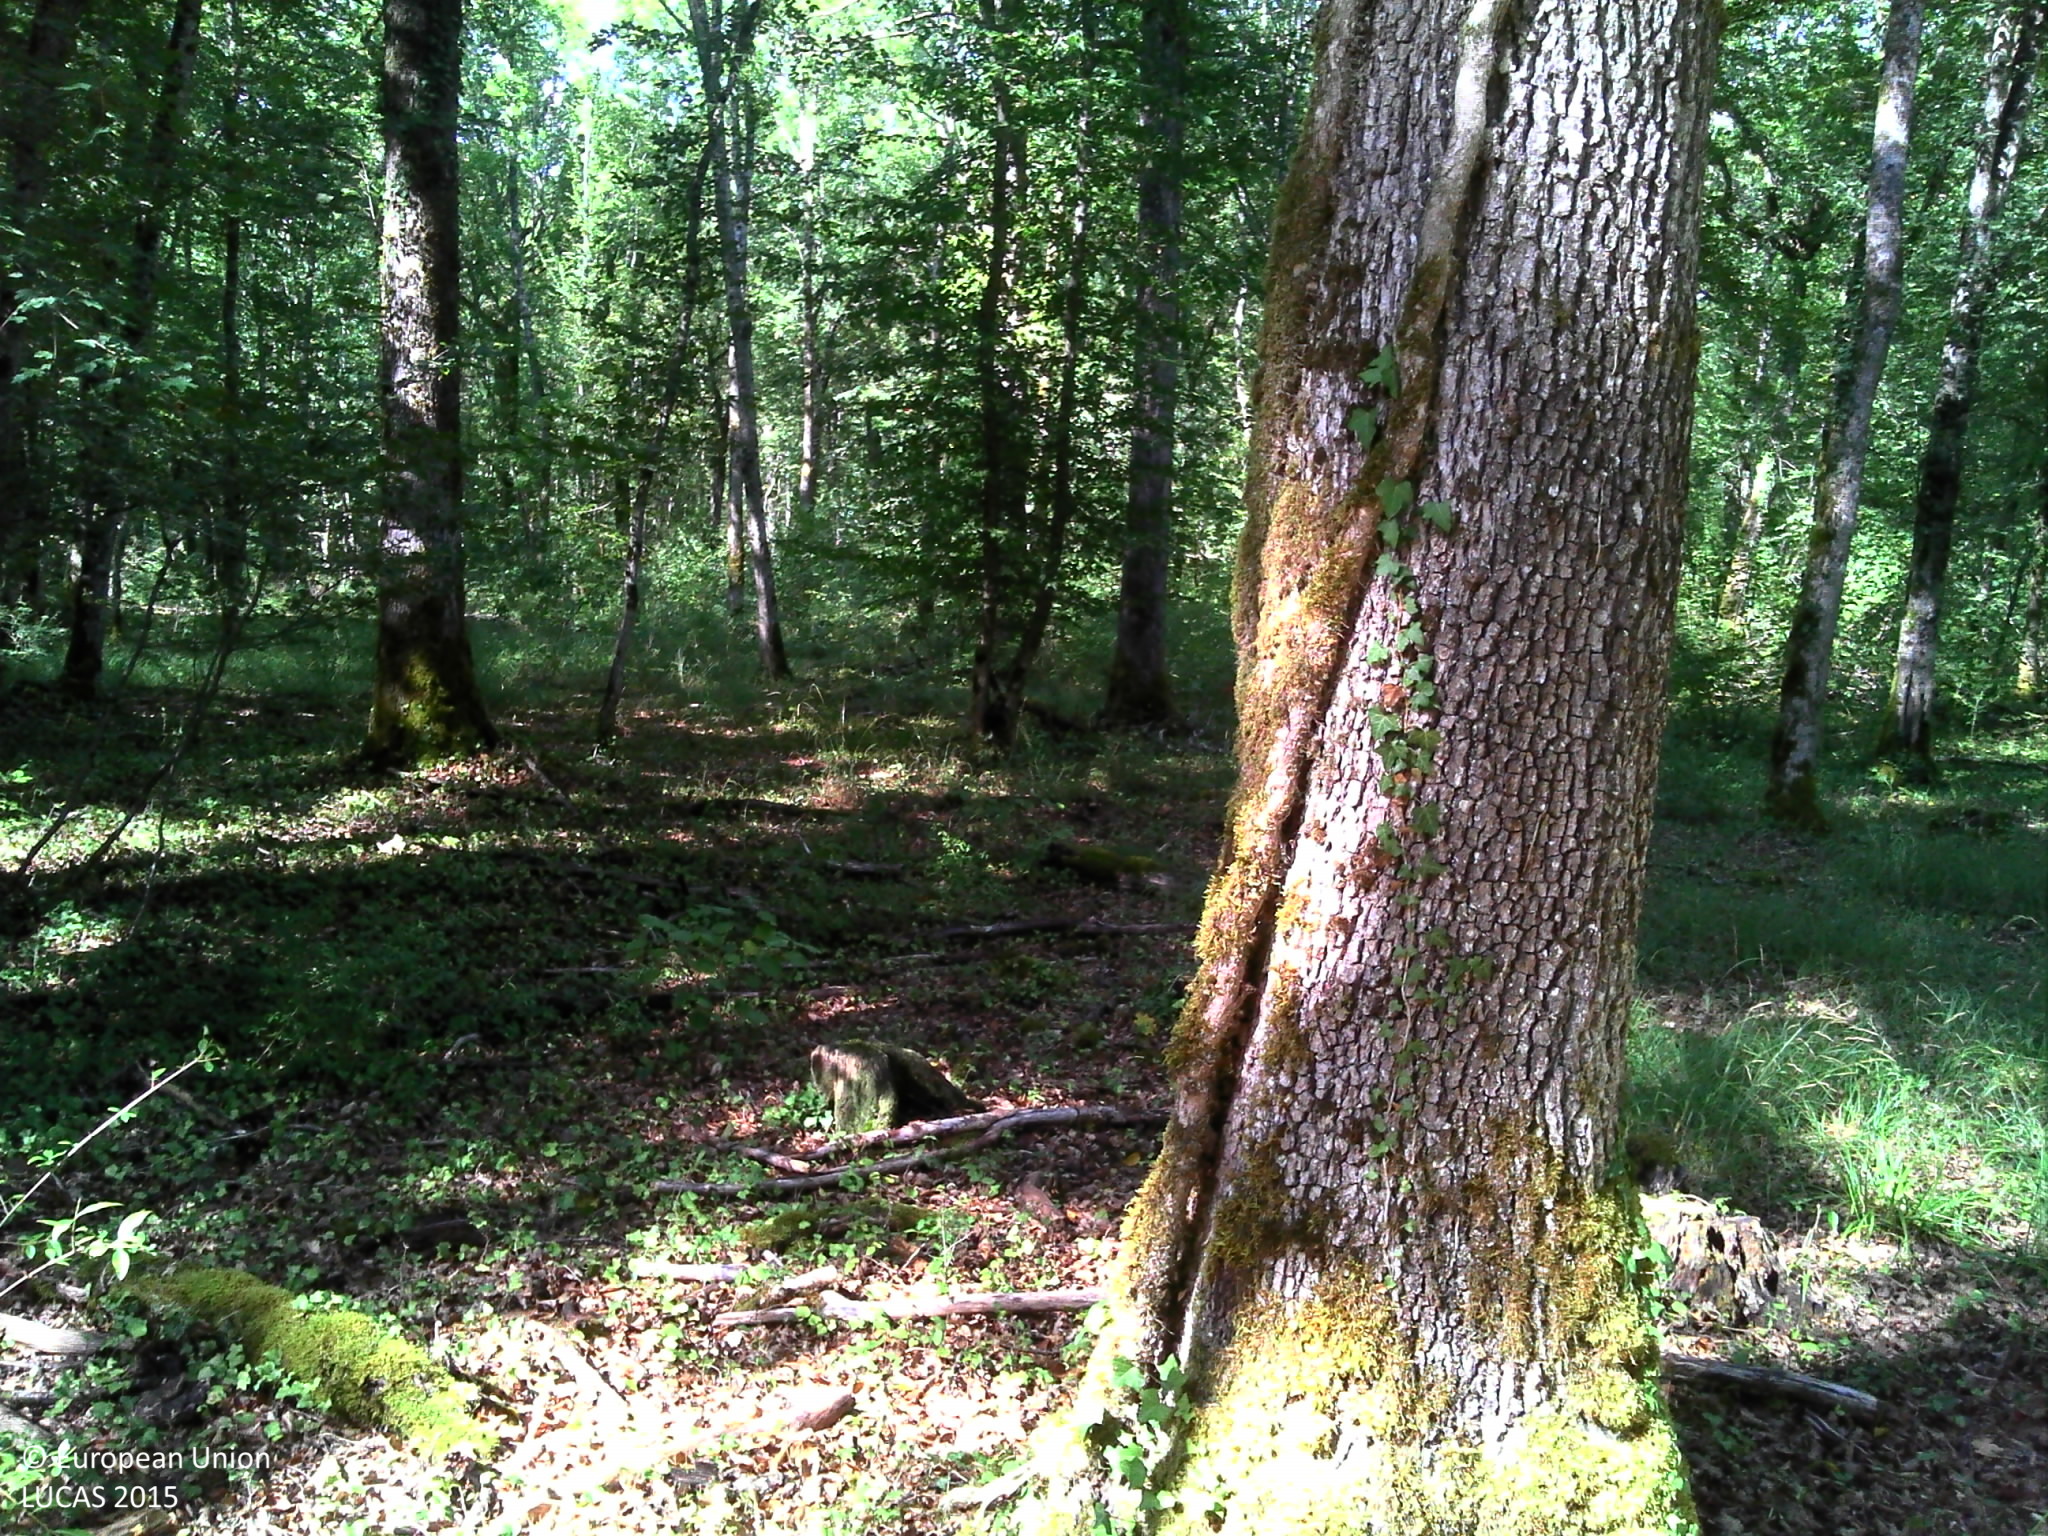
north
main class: Woodland
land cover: Broadleaved woodland
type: mesophytic deciduous forest
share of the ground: > 75 %
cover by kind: broadleaved forest trees 85 %, shrubs 5 %, herbaceous plants 5 %, lichens and mosses 5 %
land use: Forestry
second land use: Amenities, museums, leisure
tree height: > 5 m
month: August
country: FR
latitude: 47.8559
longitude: 4.9605
